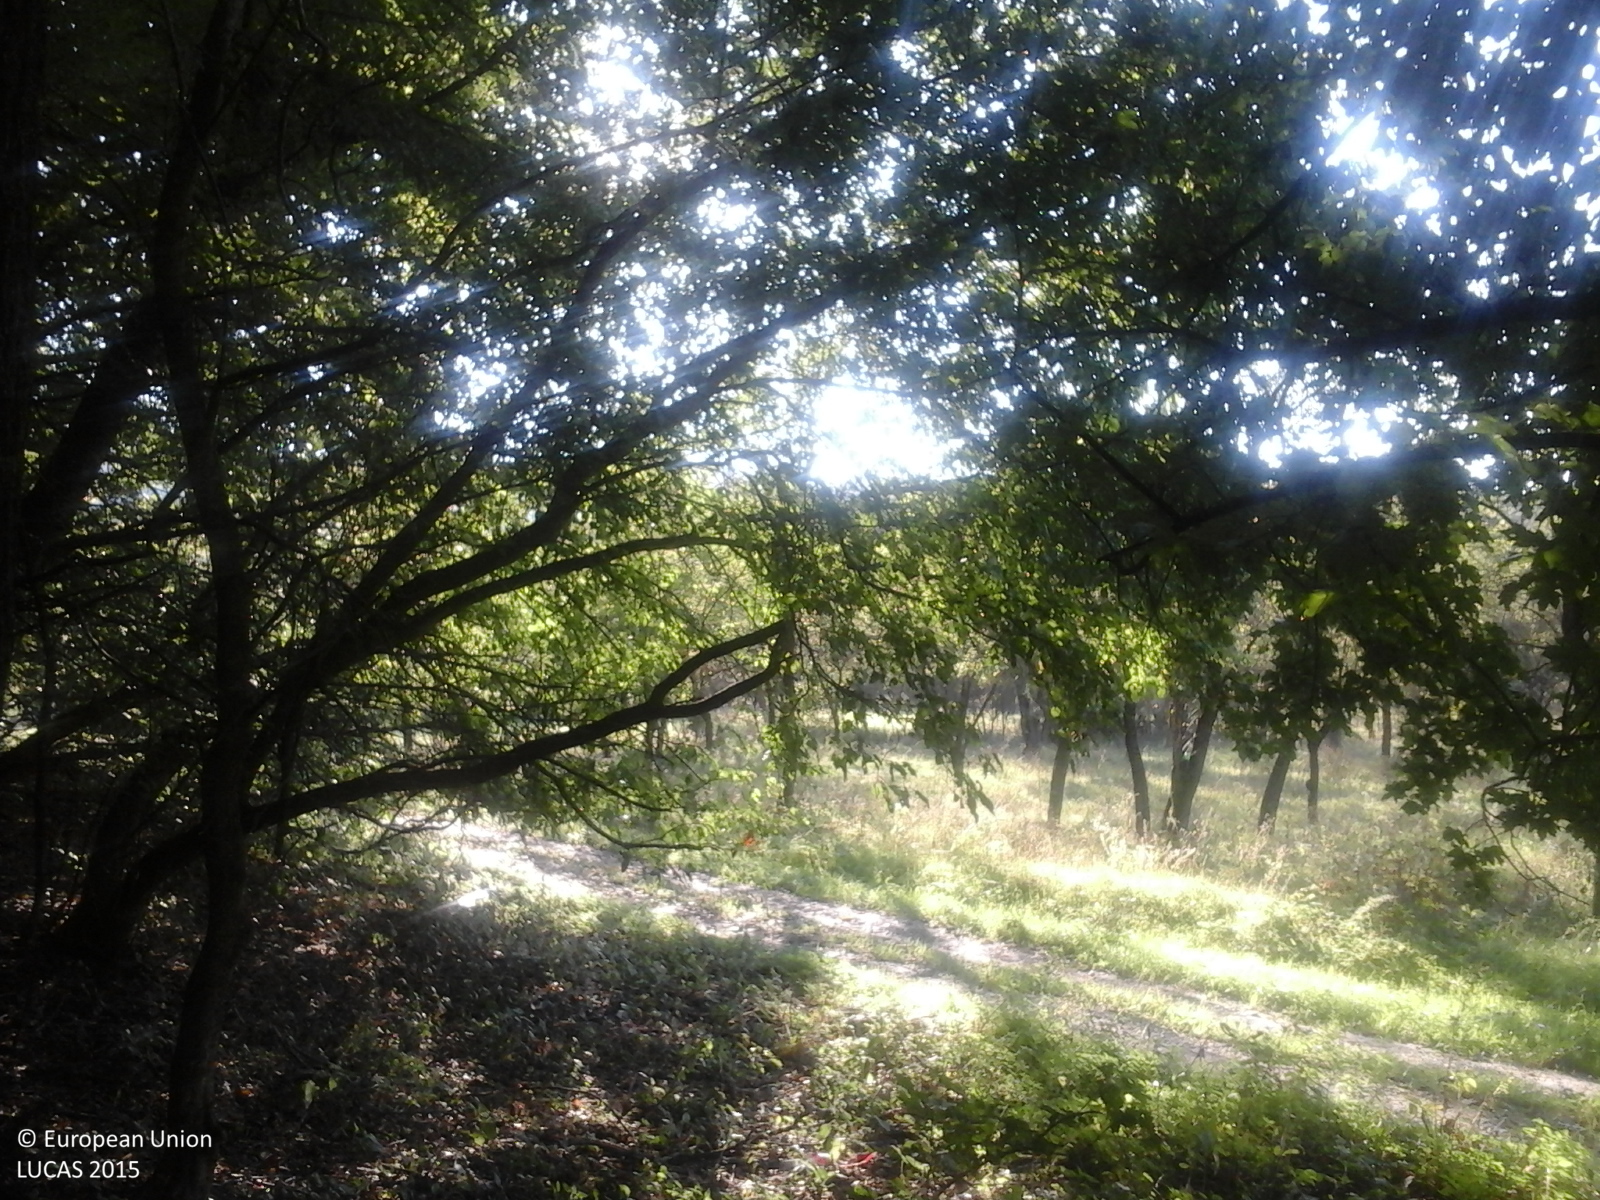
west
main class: Woodland
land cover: Broadleaved woodland
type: acidophilous oak and oak-birch forest
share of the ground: > 75 %
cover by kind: broadleaved forest trees 100 %
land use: Forestry
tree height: > 5 m
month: October
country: RO
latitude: 46.3455
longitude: 23.8064
